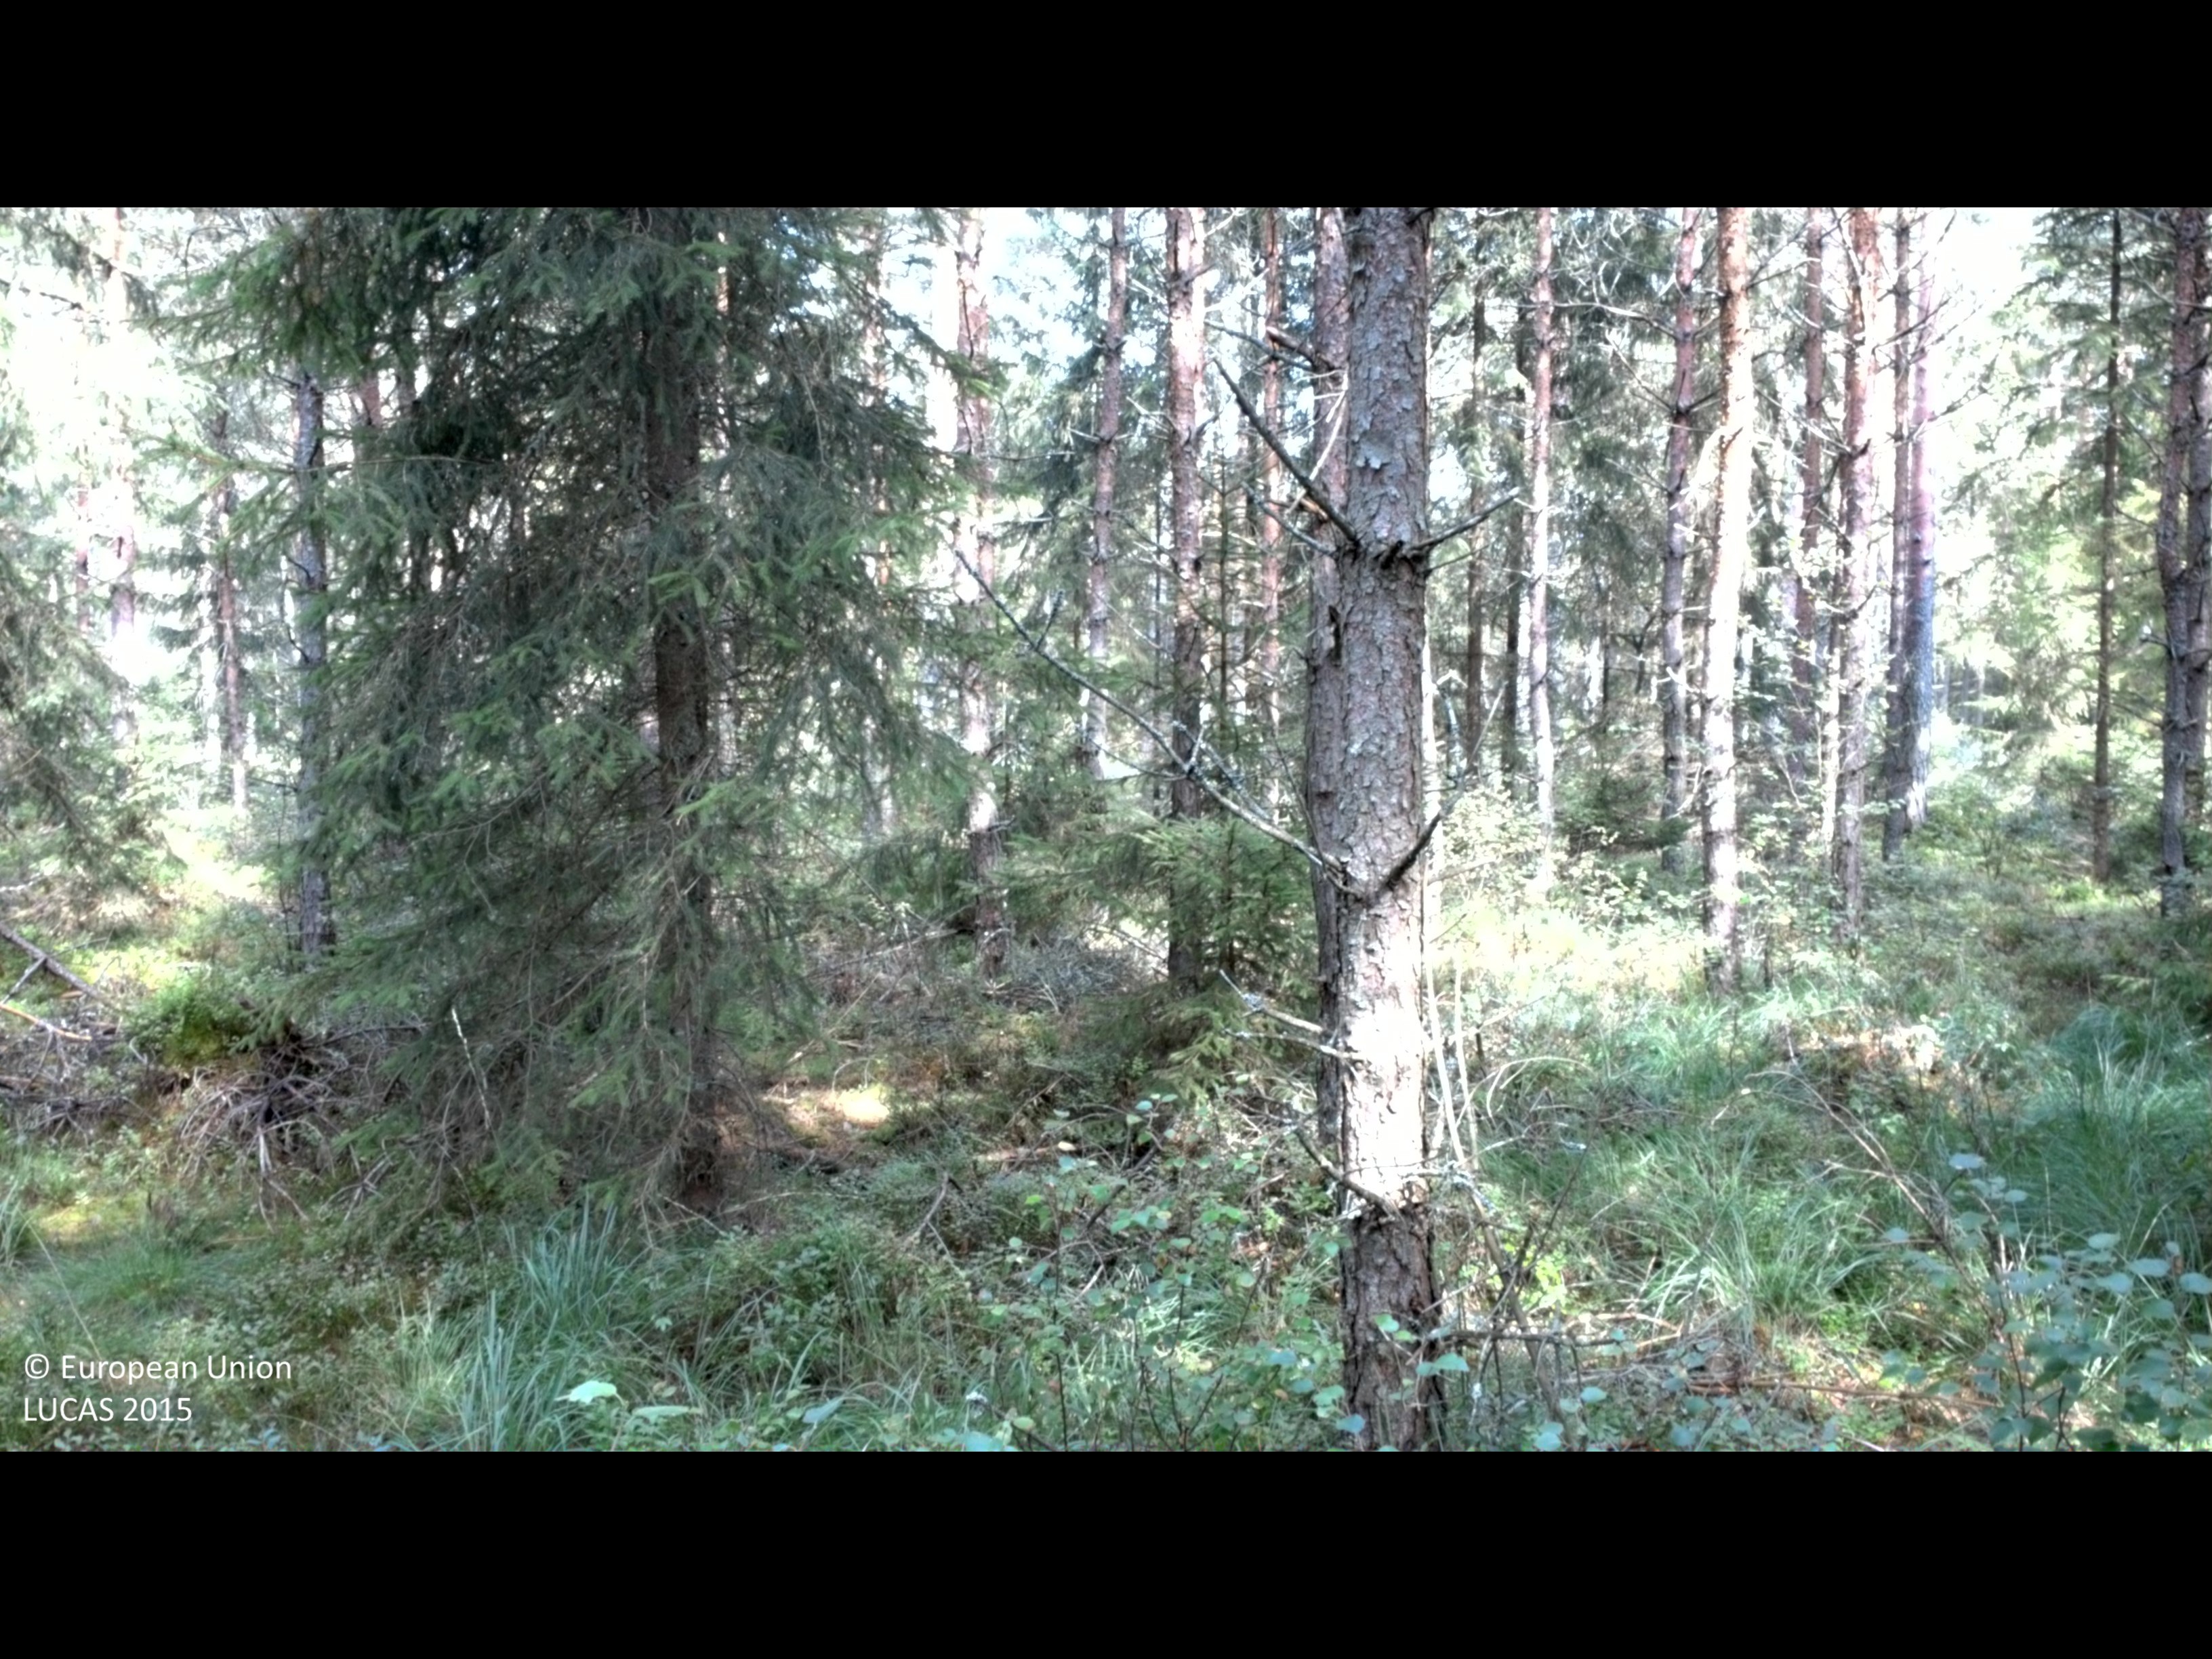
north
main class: Woodland
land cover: Pine dominated coniferous woodland
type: boreal forest
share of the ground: 50 - 75 %
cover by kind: coniferous forest trees 60 %, shrubs 20 %, herbaceous plants 15 %, broadleaved forest trees 5 %
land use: Forestry
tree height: > 5 m
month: August
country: SE
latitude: 57.1392
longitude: 13.8132
